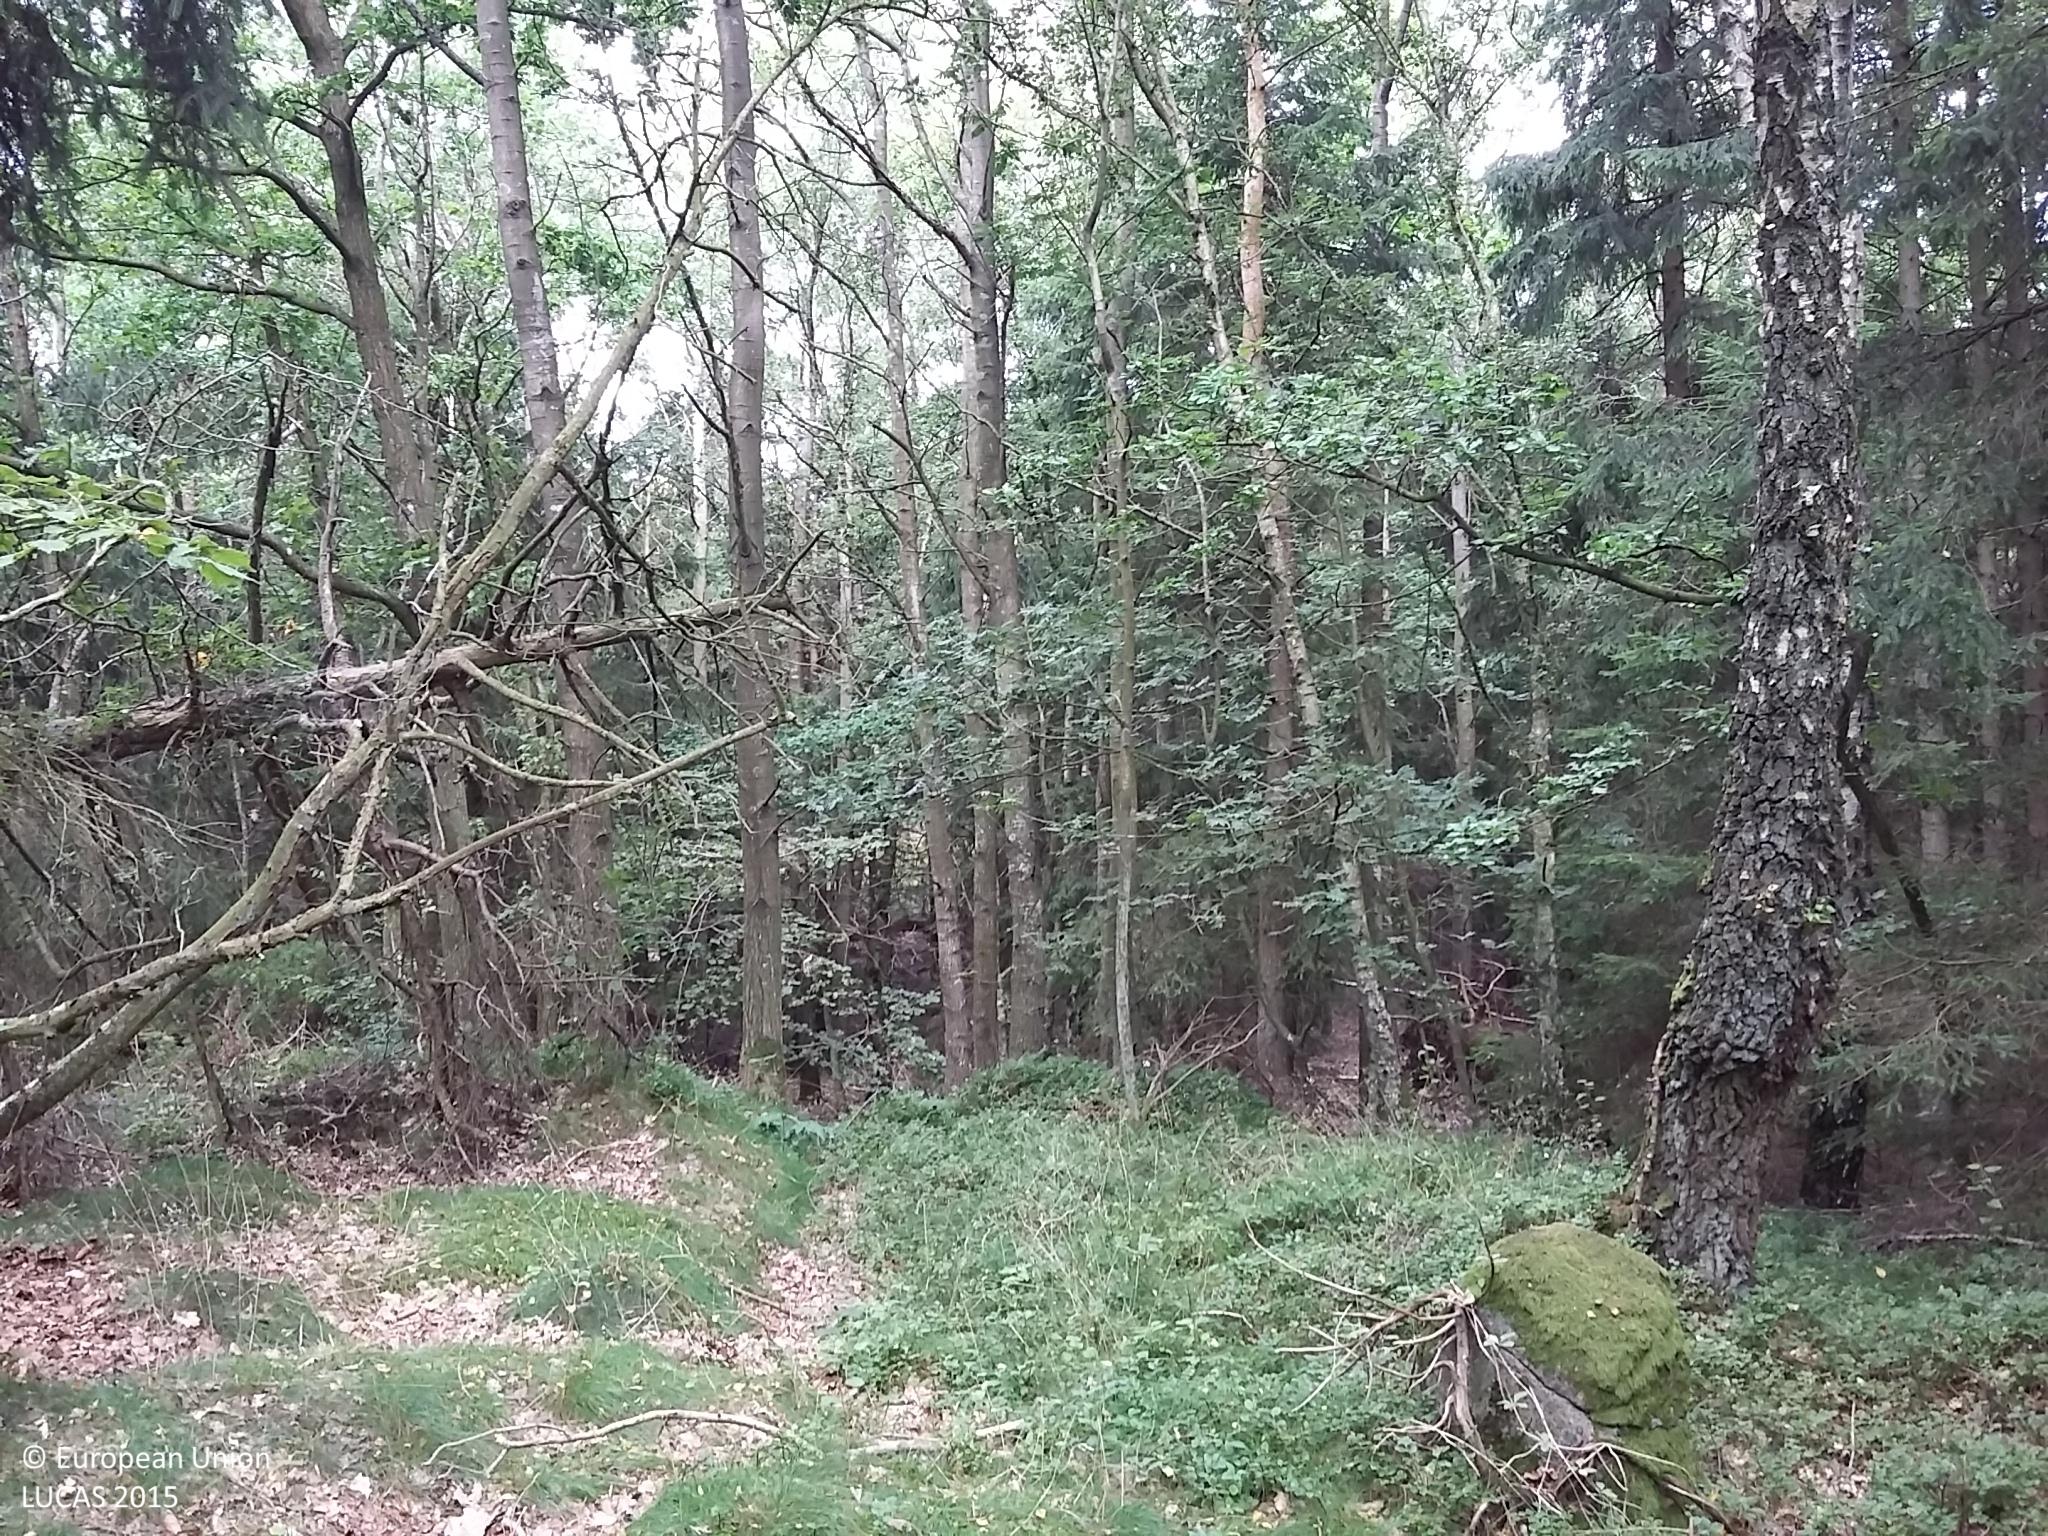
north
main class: Woodland
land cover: Other mixed woodland
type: hemiboreal forest and nemoral coniferous forest and mixed broadleaved-coniferous forest
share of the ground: > 75 %
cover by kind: coniferous forest trees 60 %, broadleaved forest trees 25 %, herbaceous plants 10 %, lichens and mosses 5 %
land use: Semi-natural and natural areas not in use
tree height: > 5 m
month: August
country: DK
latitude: 55.2529
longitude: 14.7667
